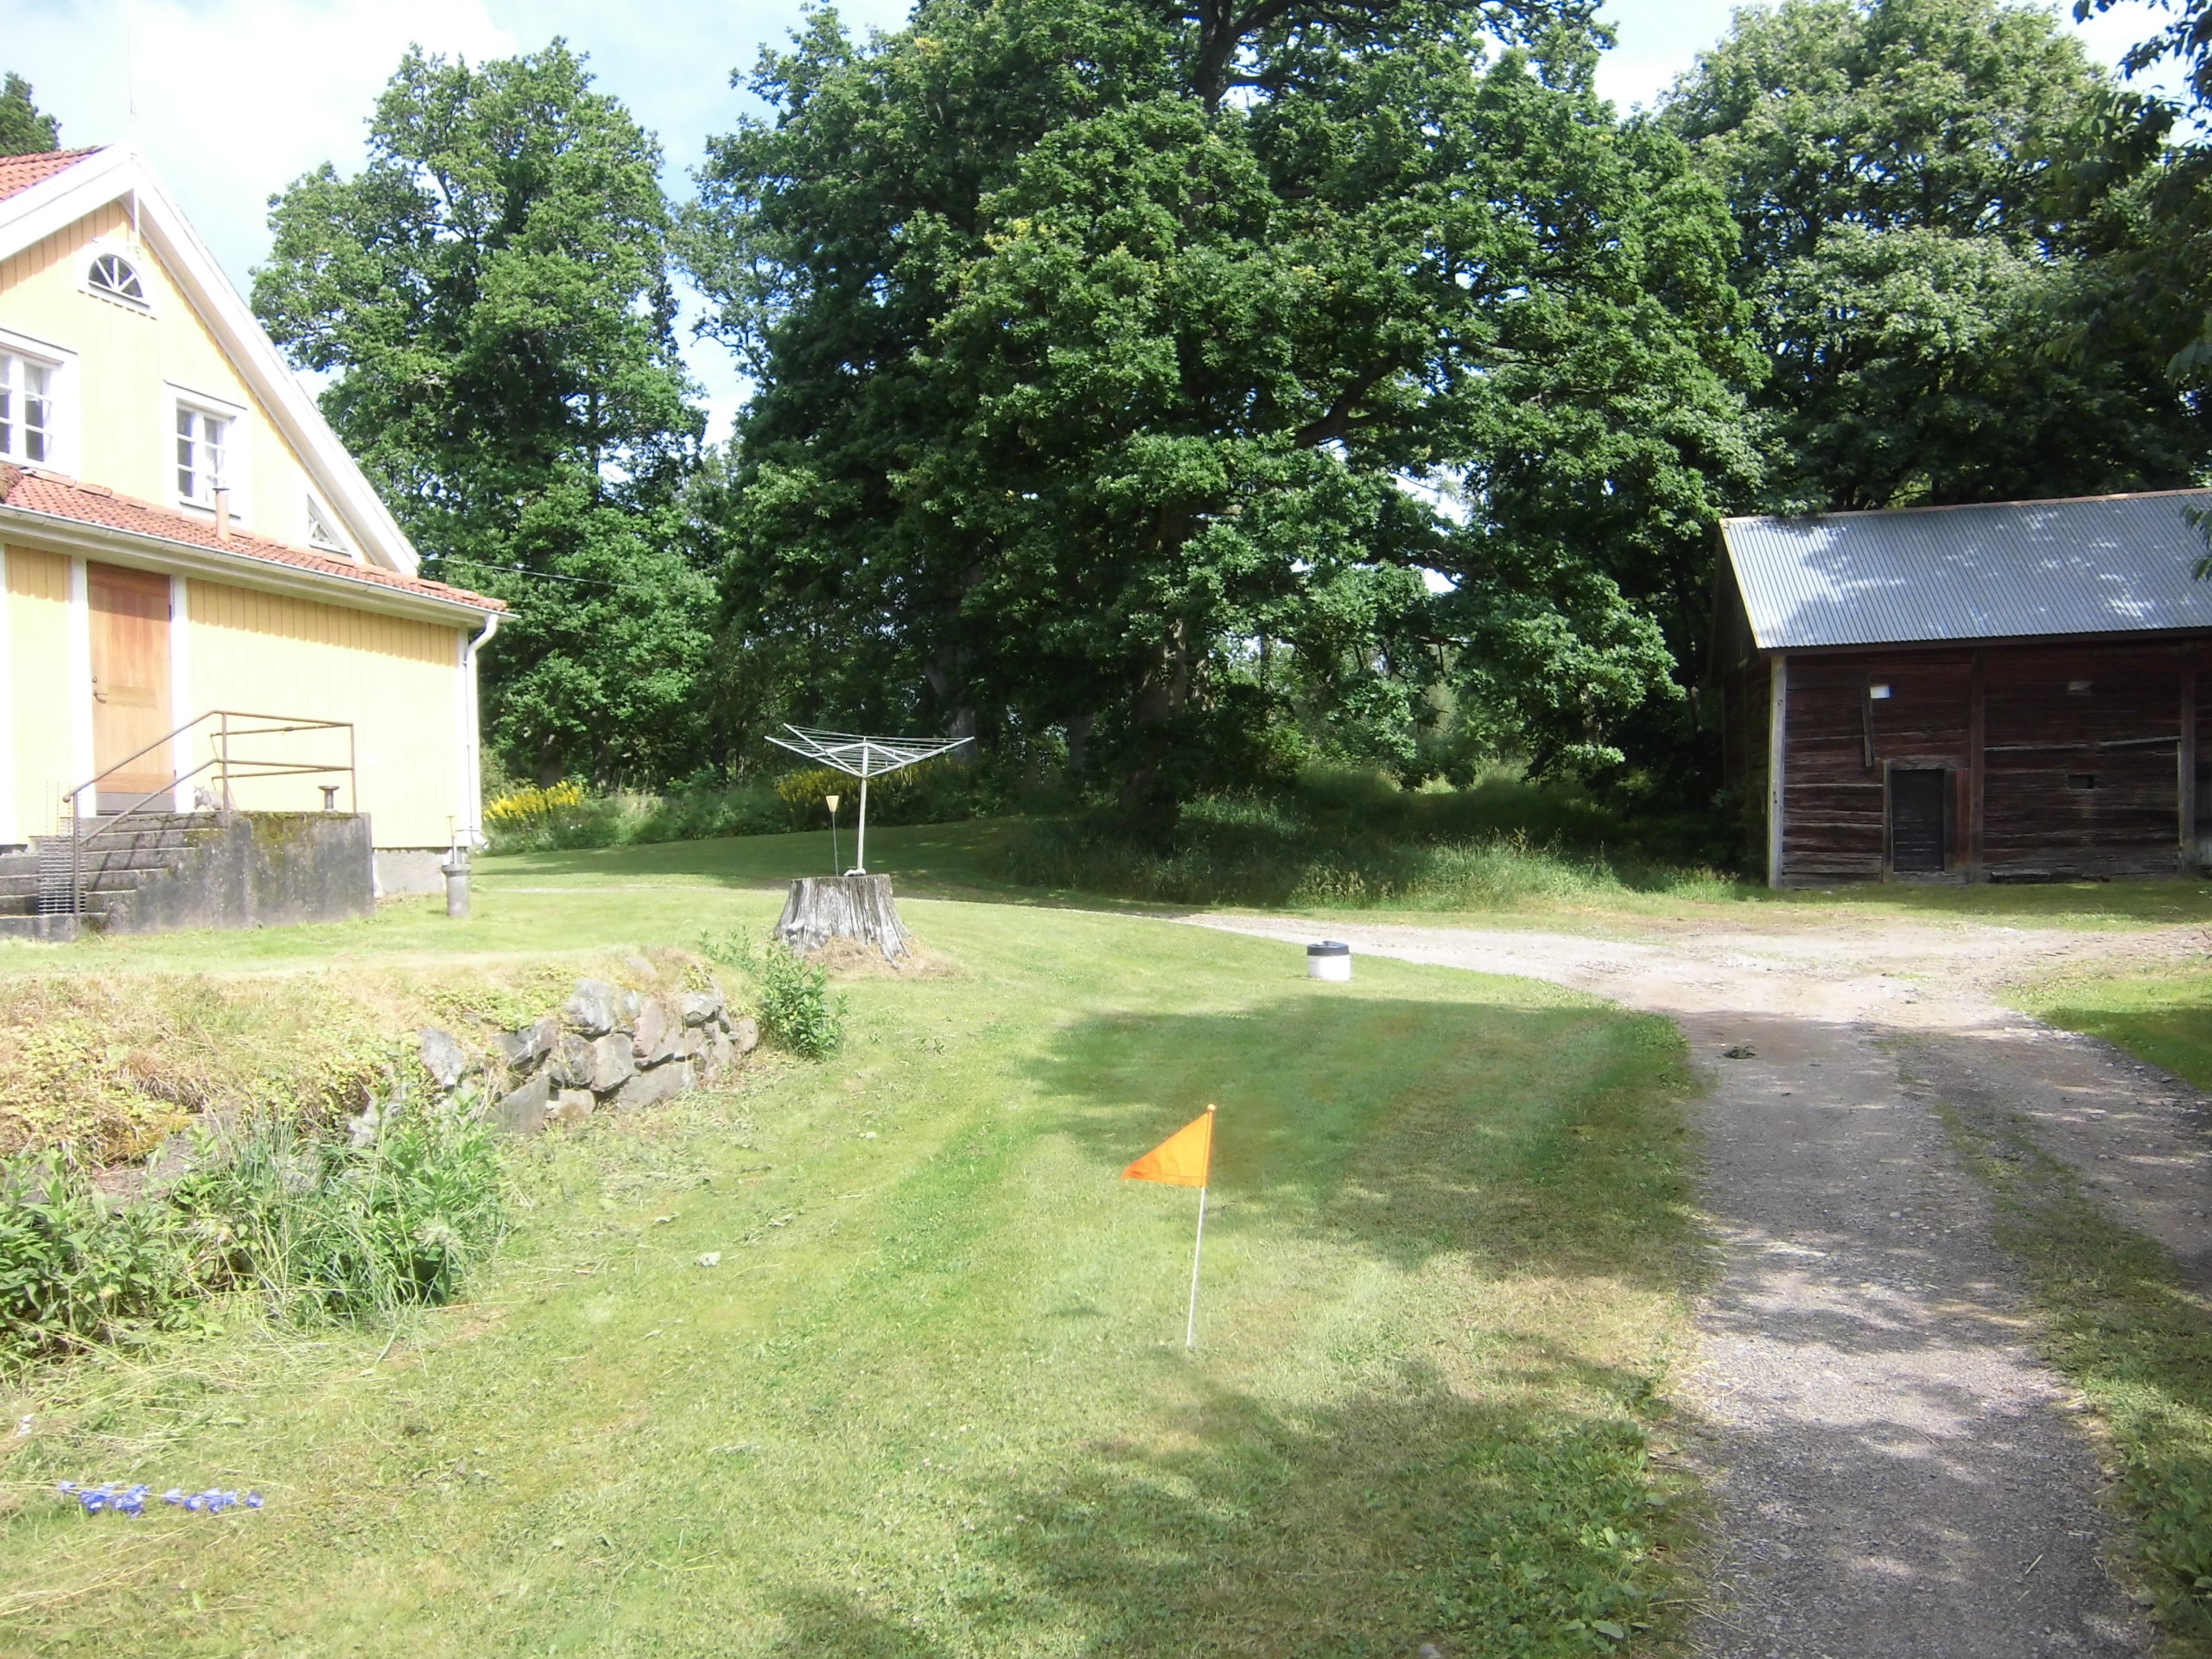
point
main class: Grassland
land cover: Grassland without tree/shrub cover
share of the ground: > 75 %
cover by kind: herbaceous plants 100 %
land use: Residential
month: July
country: SE
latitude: 57.1375
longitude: 15.4007
